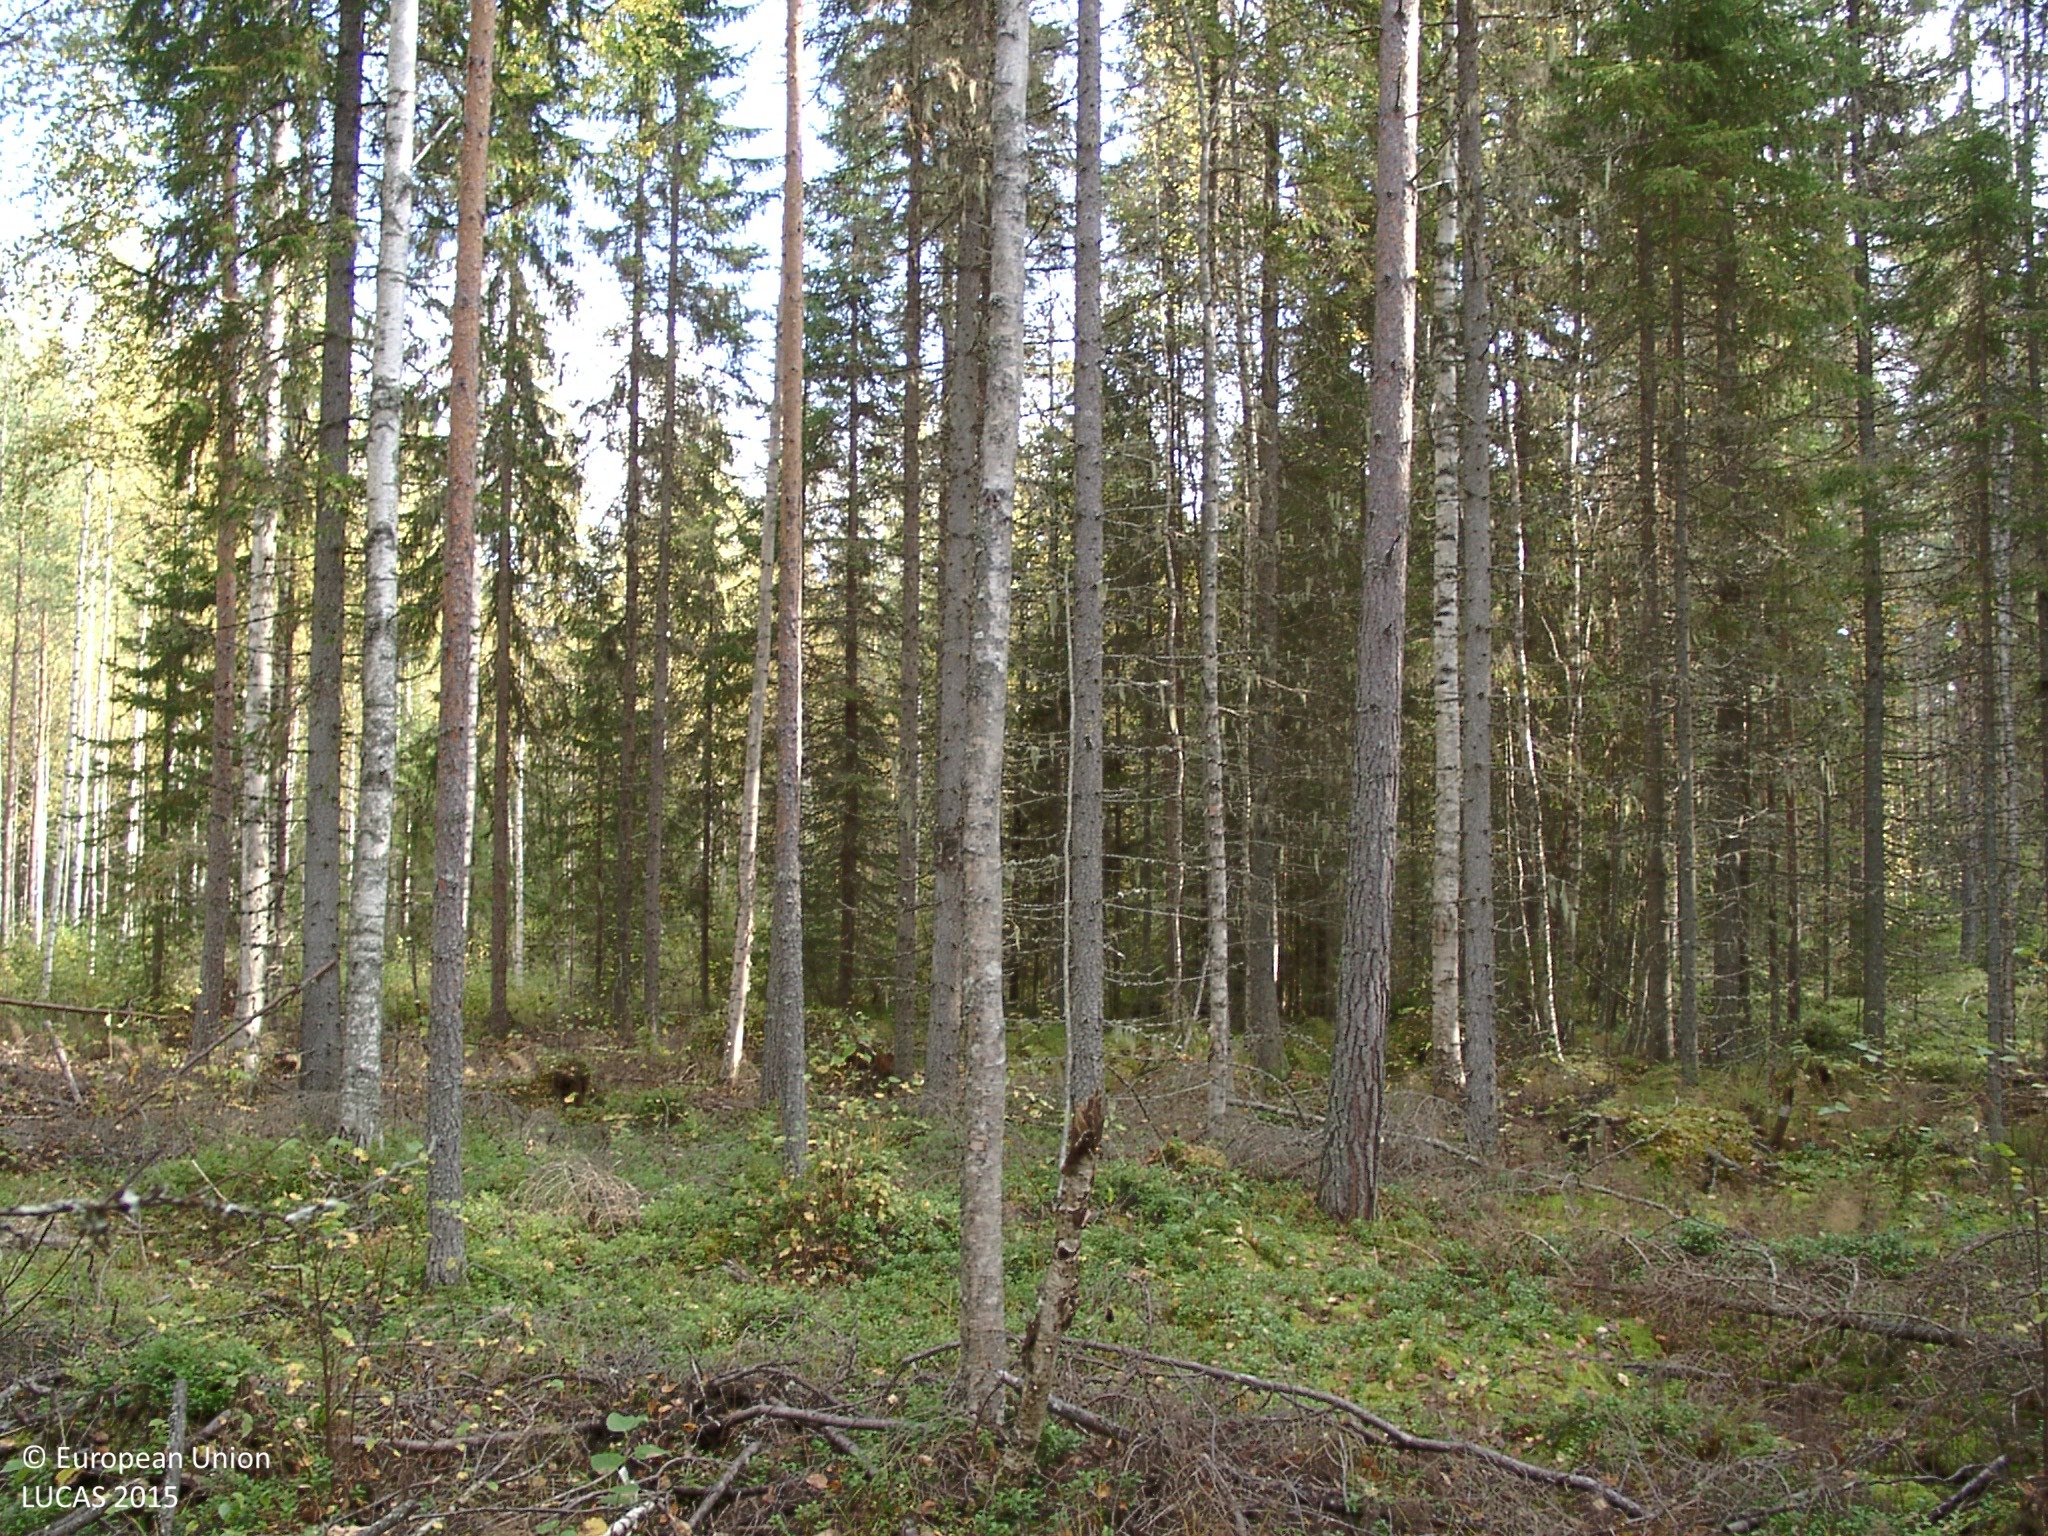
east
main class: Woodland
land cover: Spruce dominated mixed woodland
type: boreal forest
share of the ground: 50 - 75 %
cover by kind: coniferous forest trees 45 %, broadleaved forest trees 15 %, shrubs 15 %, lichens and mosses 10 %, herbaceous plants 5 %
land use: Forestry
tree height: > 5 m
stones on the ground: < 10 %
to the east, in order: Spruce dominated mixed woodland; Other mixed woodland; Ditches and canals; Spruce dominated mixed woodland; Other coniferous woodland; Spruce dominated mixed woodland; Other mixed woodland
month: September
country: FI
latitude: 62.6214
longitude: 25.2498
